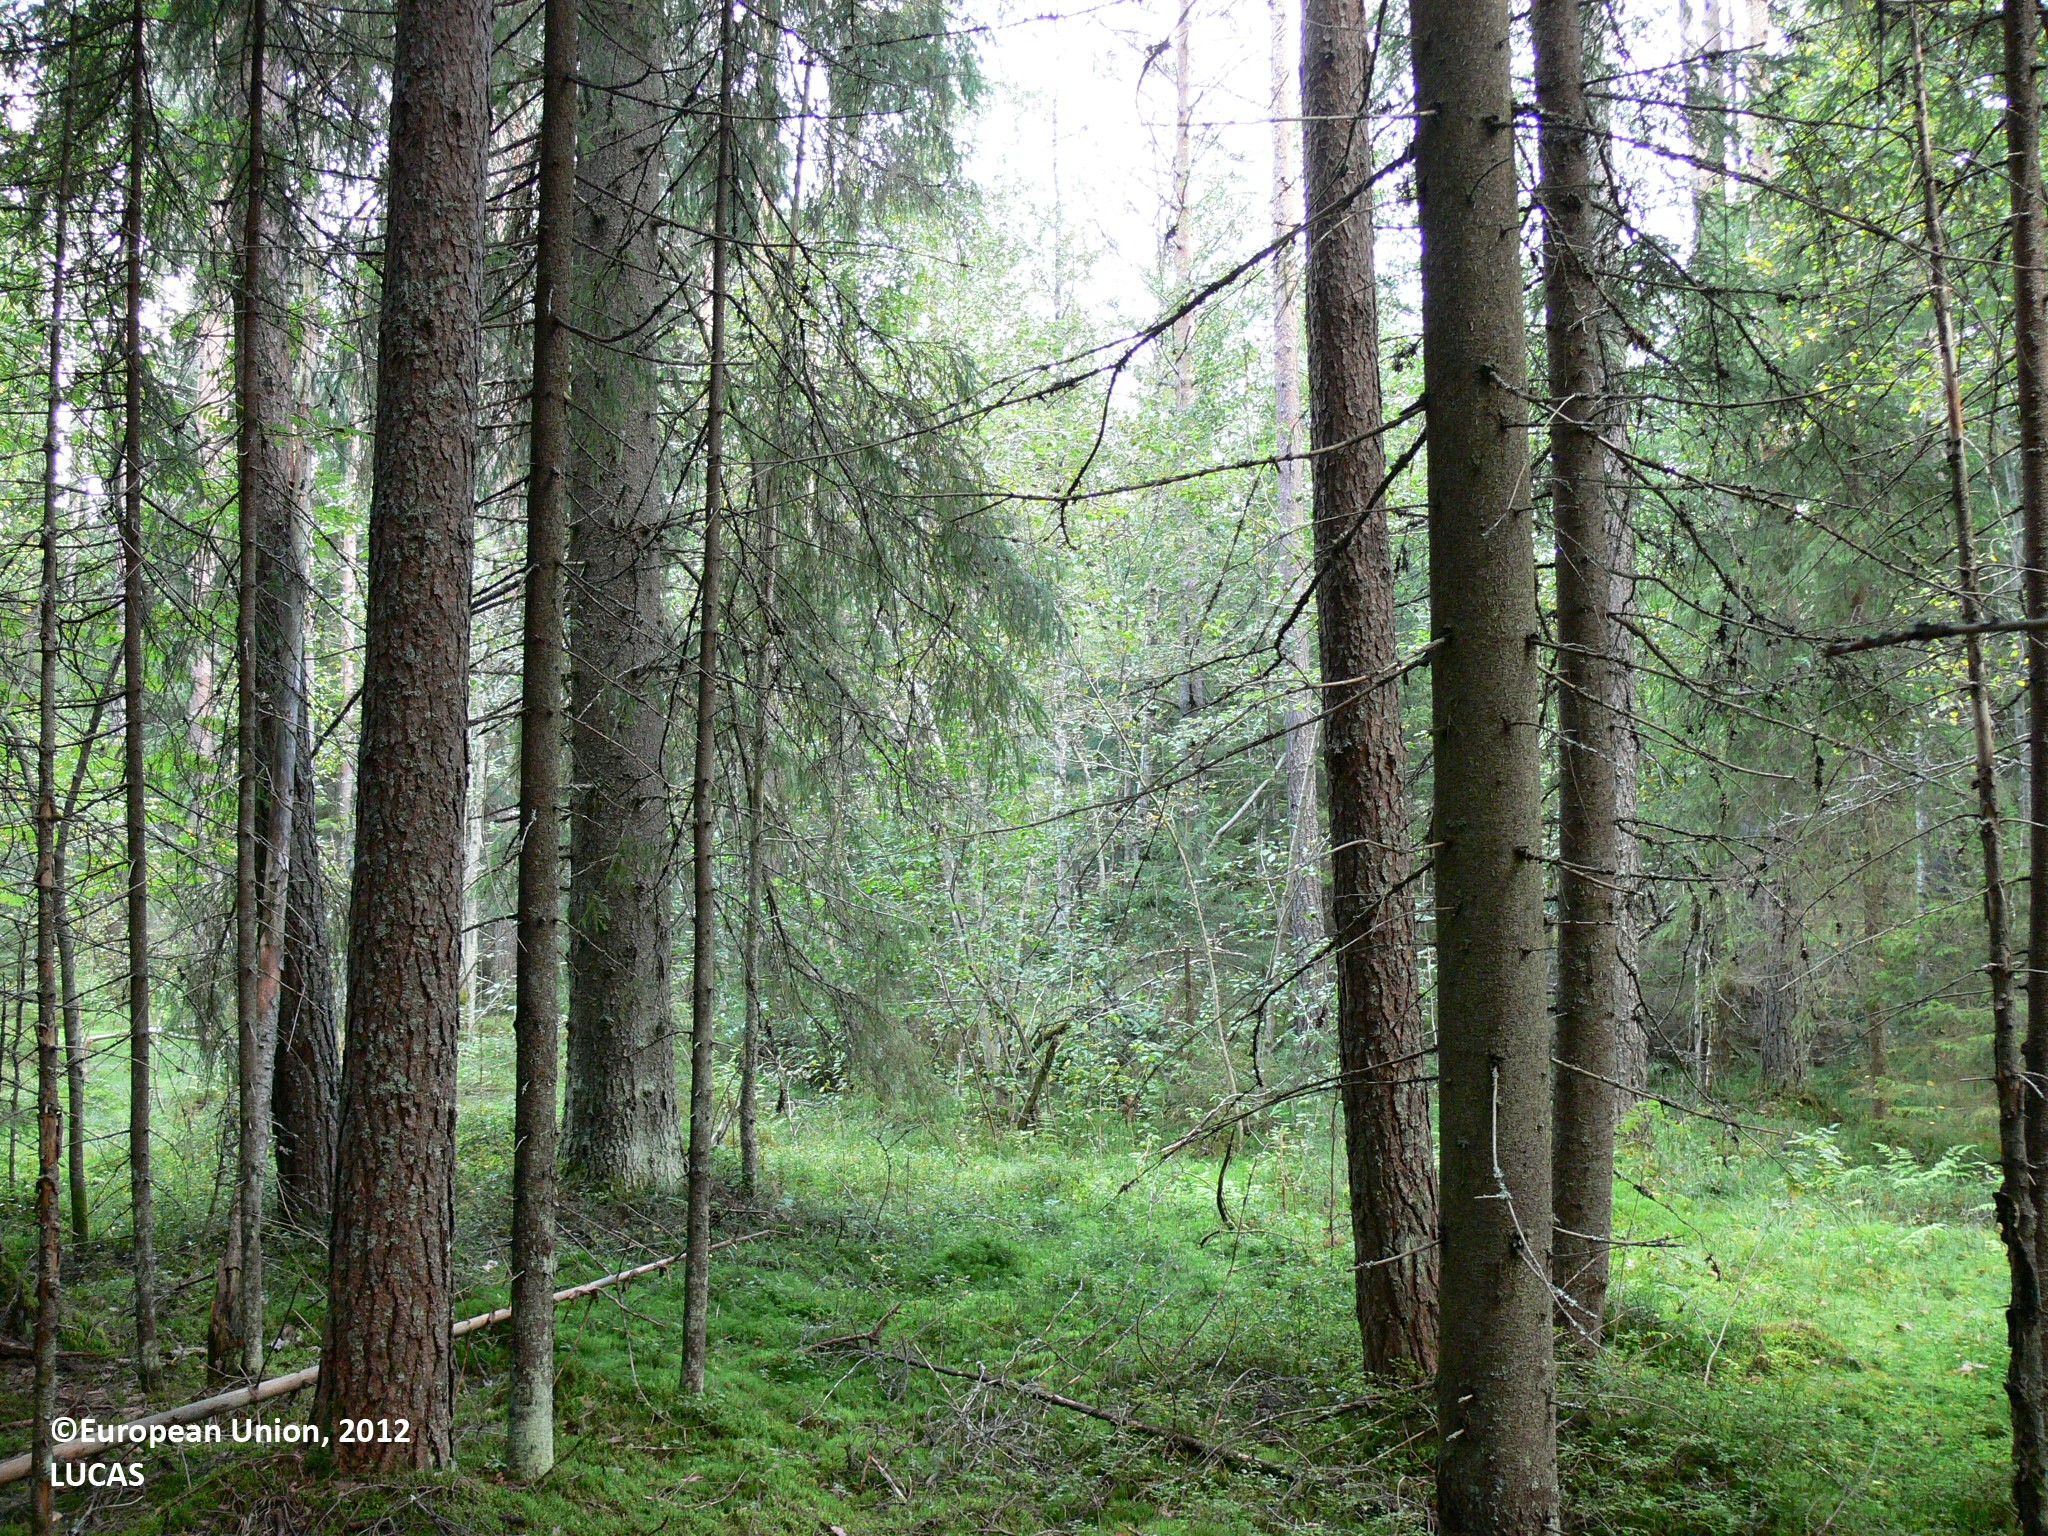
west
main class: Woodland
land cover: Other coniferous woodland
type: boreal forest
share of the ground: > 75 %
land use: Forestry
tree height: > 5 m
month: August
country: FI
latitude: 61.9783
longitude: 30.2546
